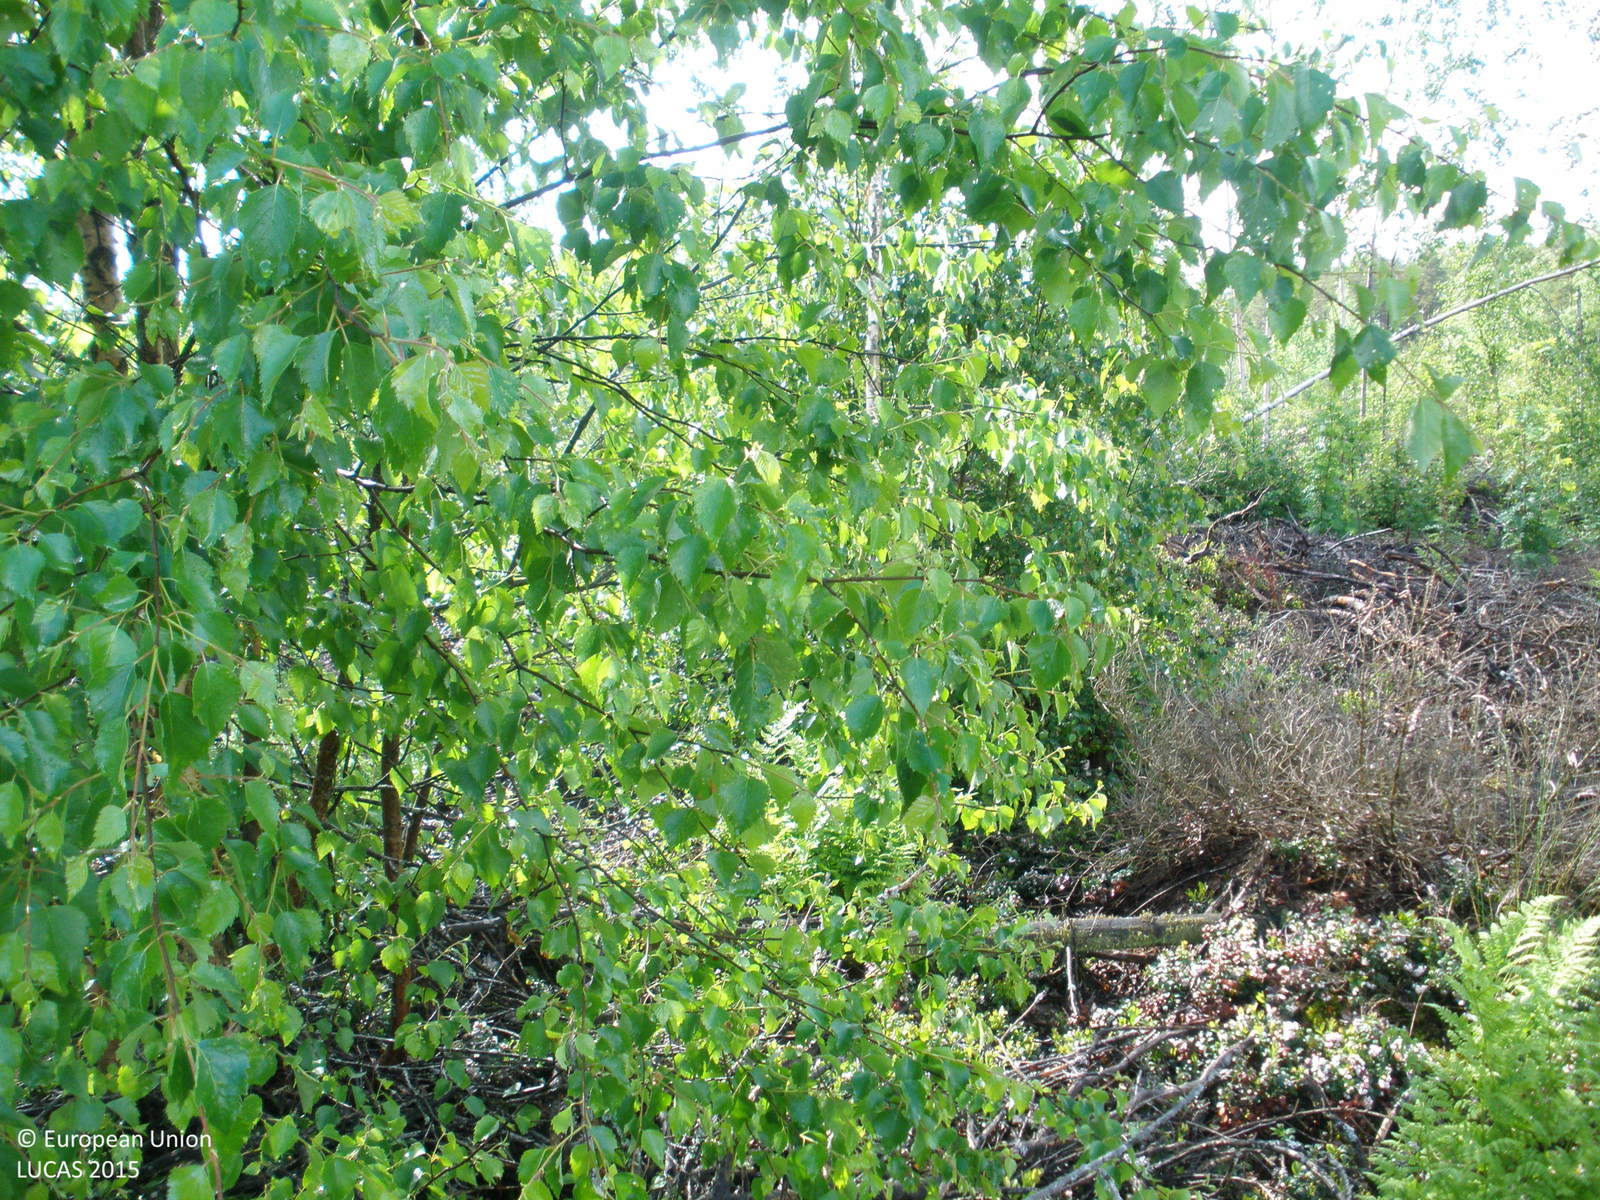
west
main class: Cropland
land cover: Temporary grasslands
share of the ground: > 75 %
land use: Agriculture (excluding fallow land and kitchen gardens)
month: June
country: FI
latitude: 60.9199
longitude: 23.4927
